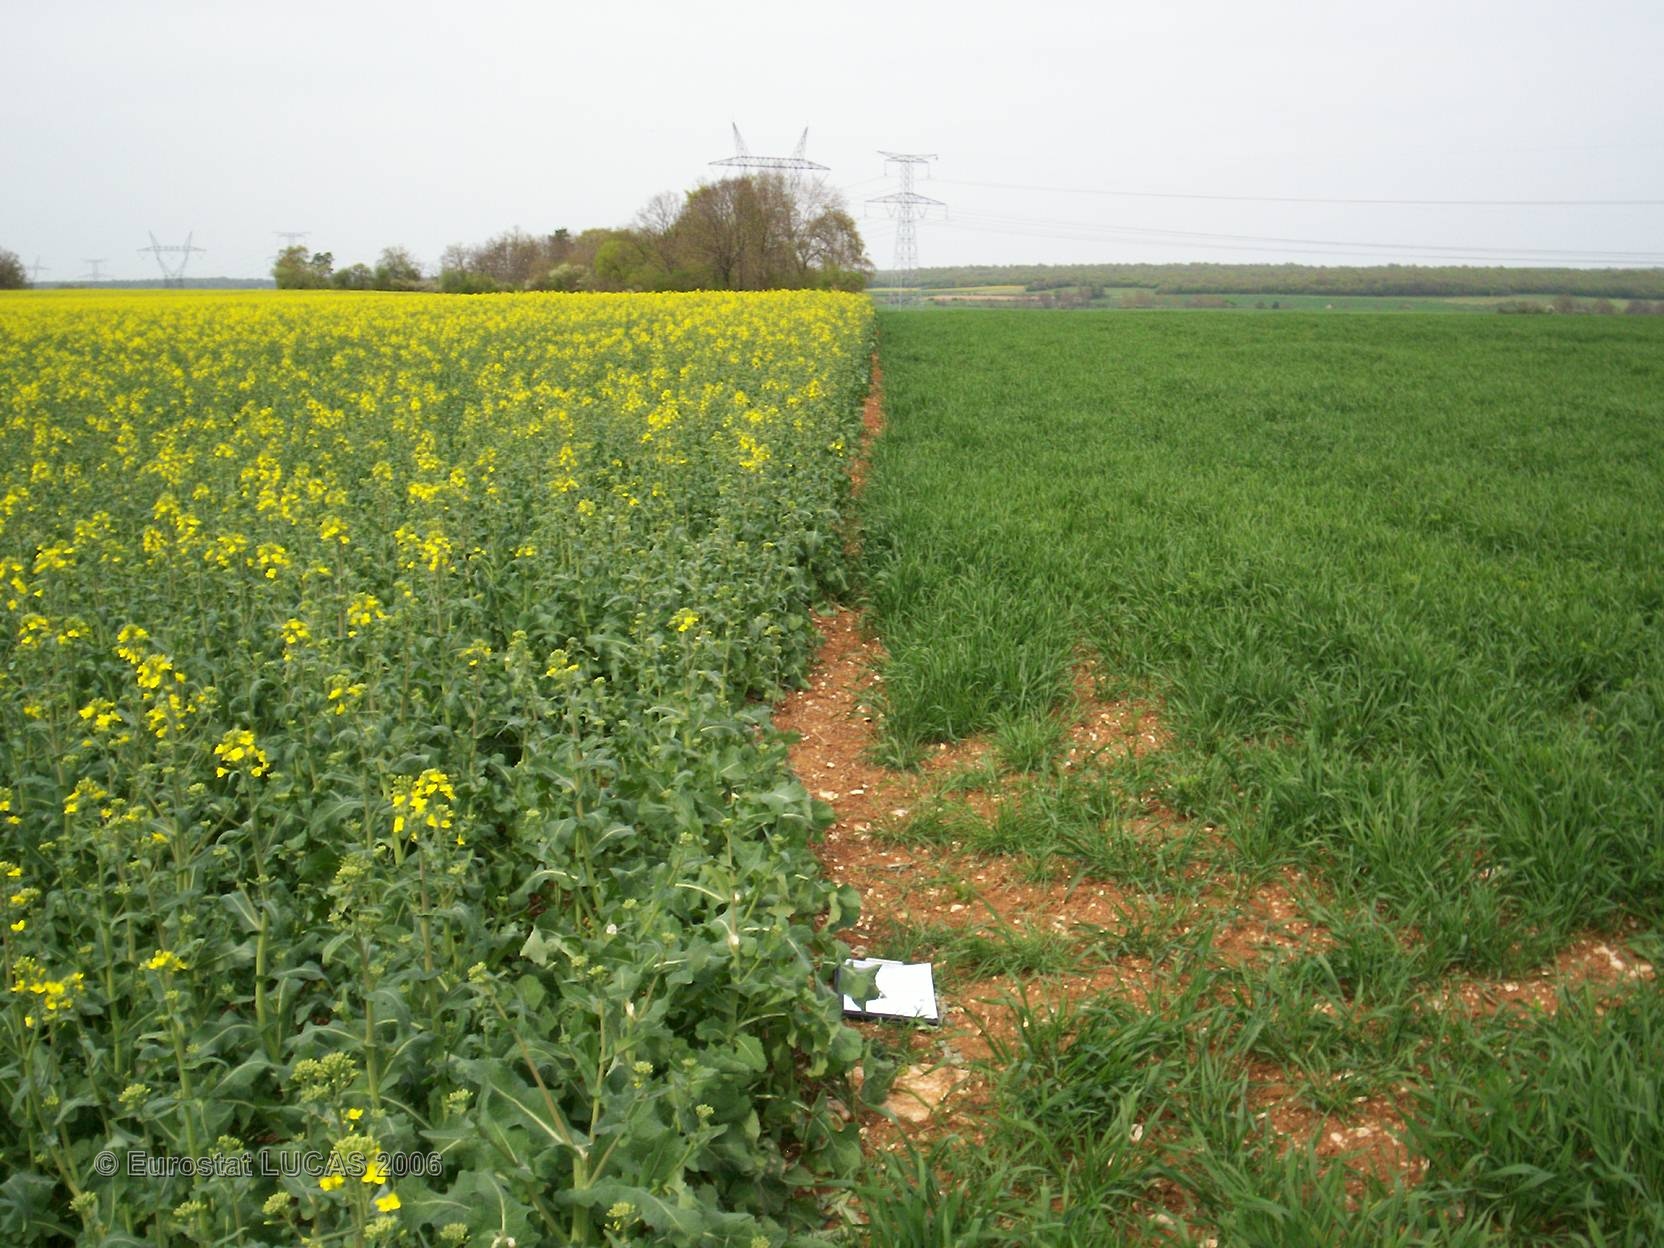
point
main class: Cropland
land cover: Rape and turnip rape
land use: Agriculture (excluding fallow land and kitchen gardens)
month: May
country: FR
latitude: 47.6547
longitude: 4.5267
